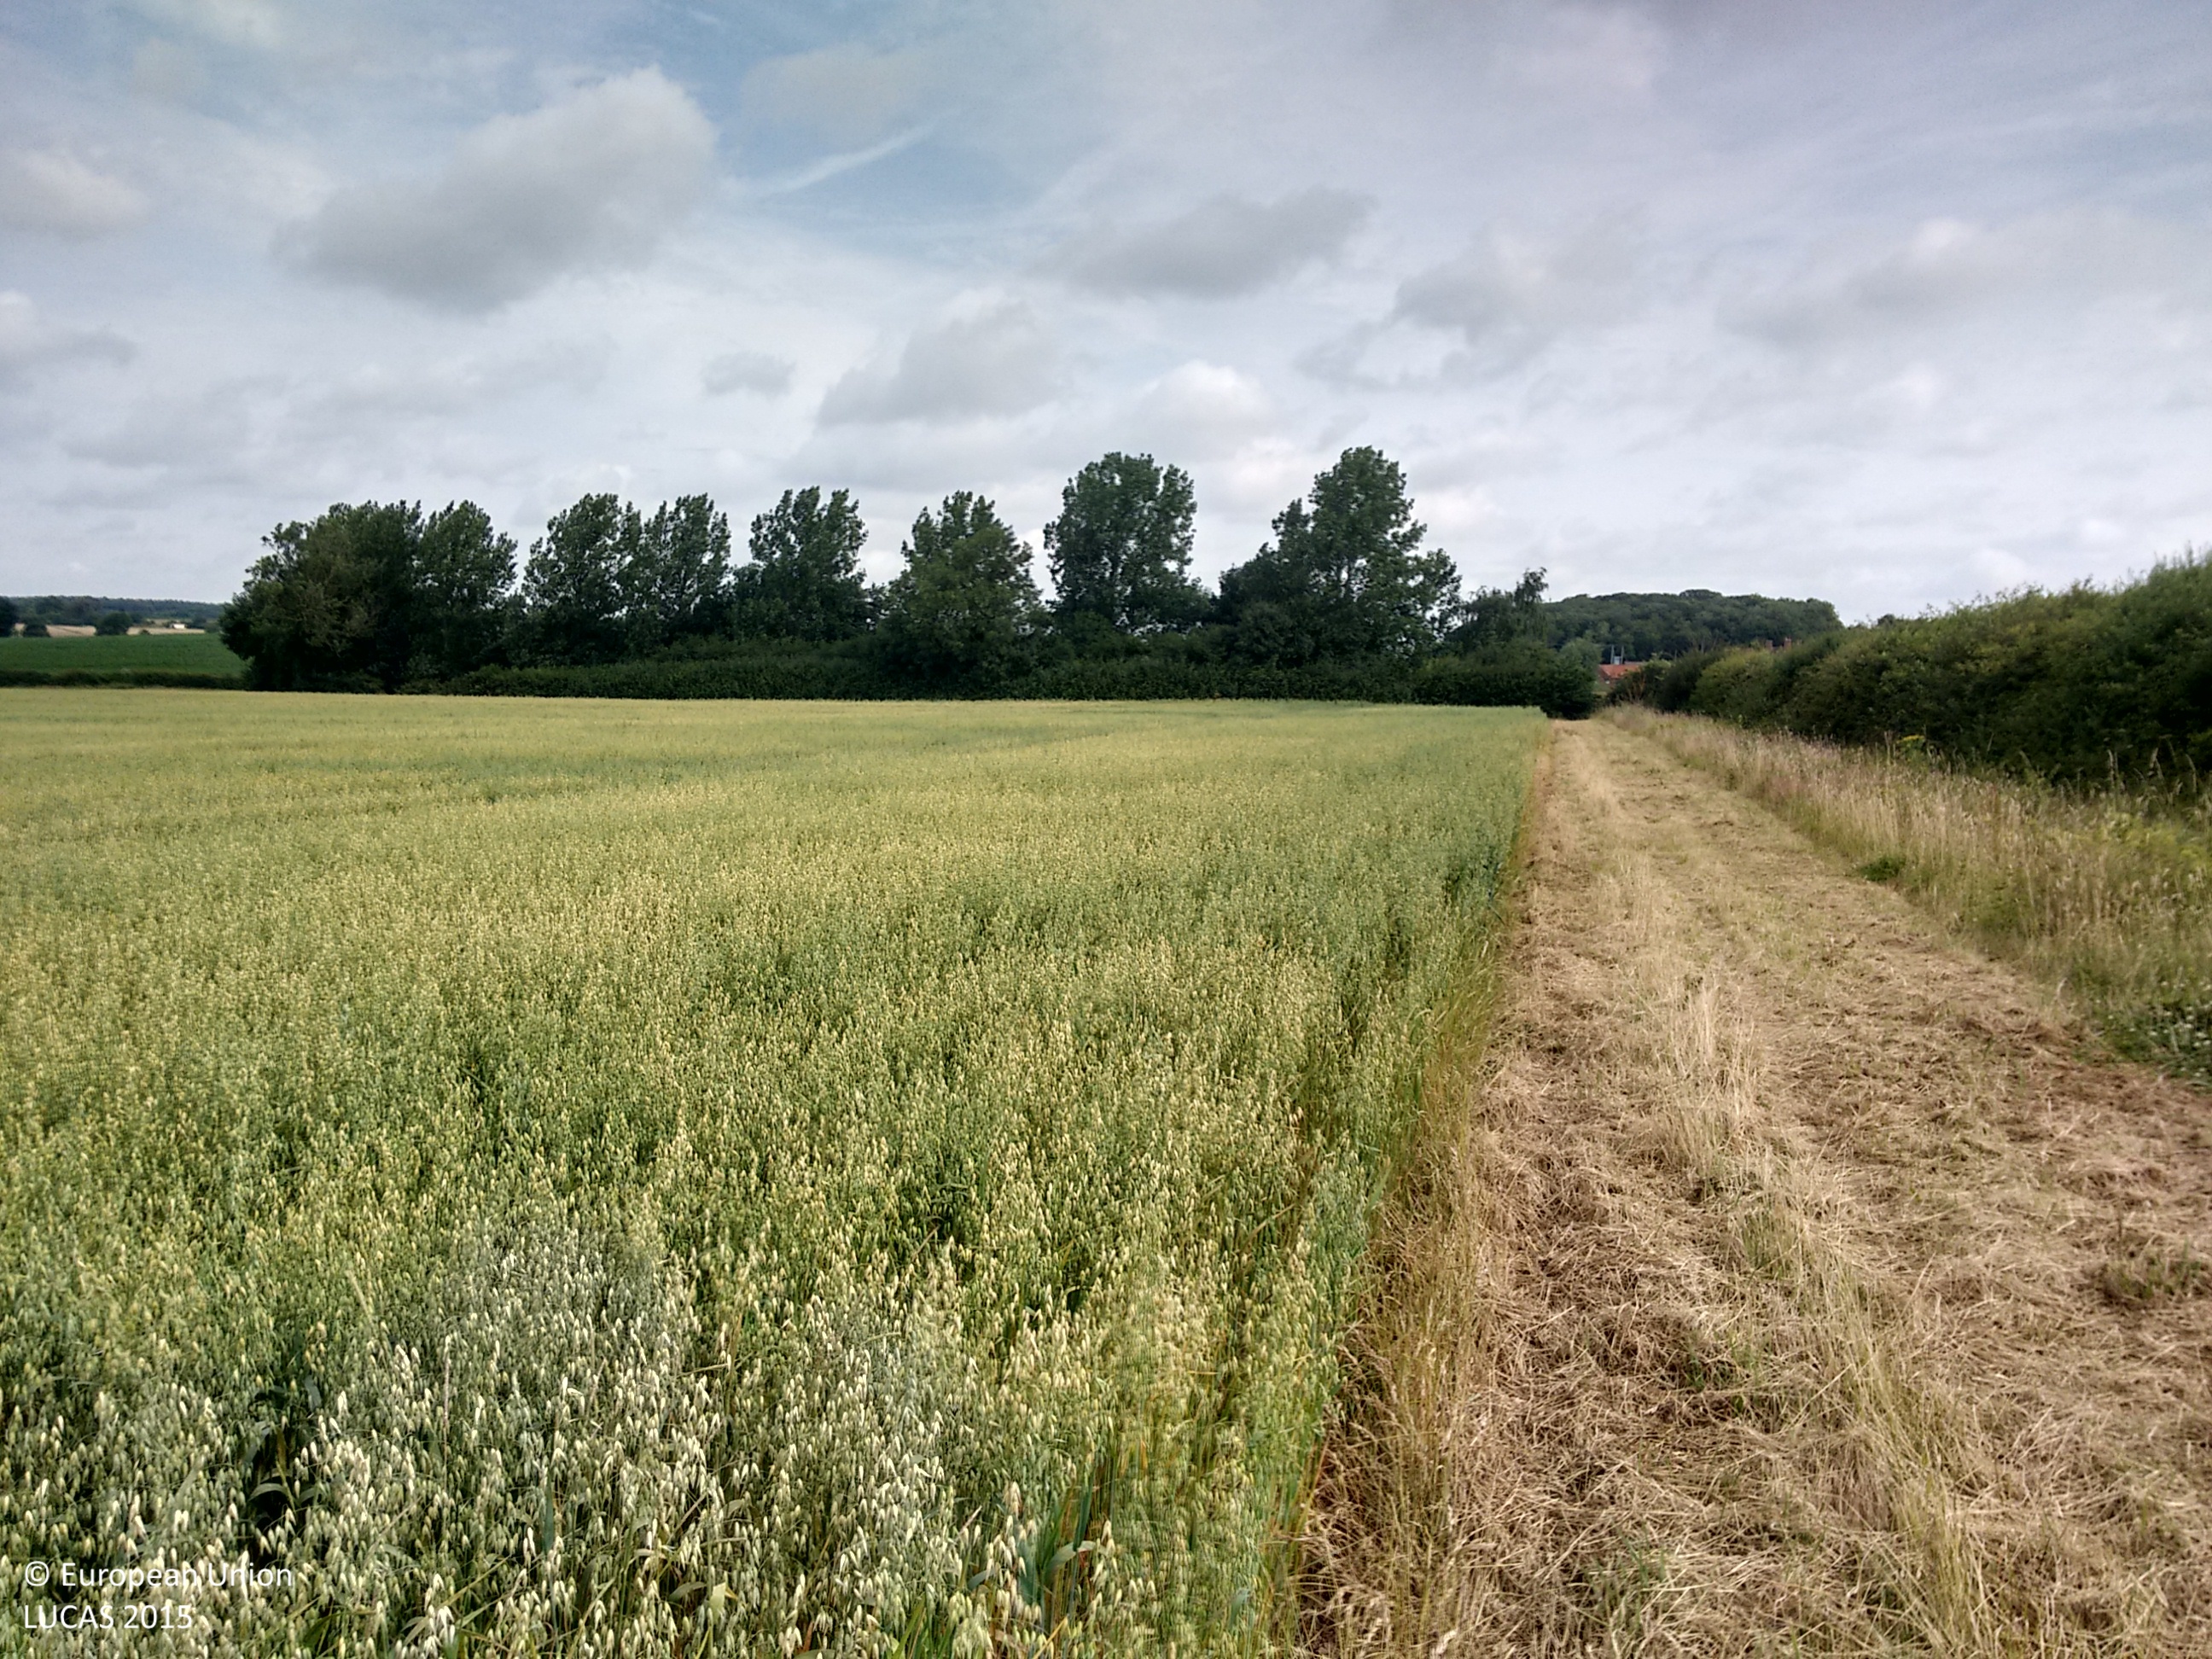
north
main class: Cropland
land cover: Oats
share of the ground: > 75 %
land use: Agriculture (excluding fallow land and kitchen gardens)
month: July
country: GB
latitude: 53.1077
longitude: -0.9023
